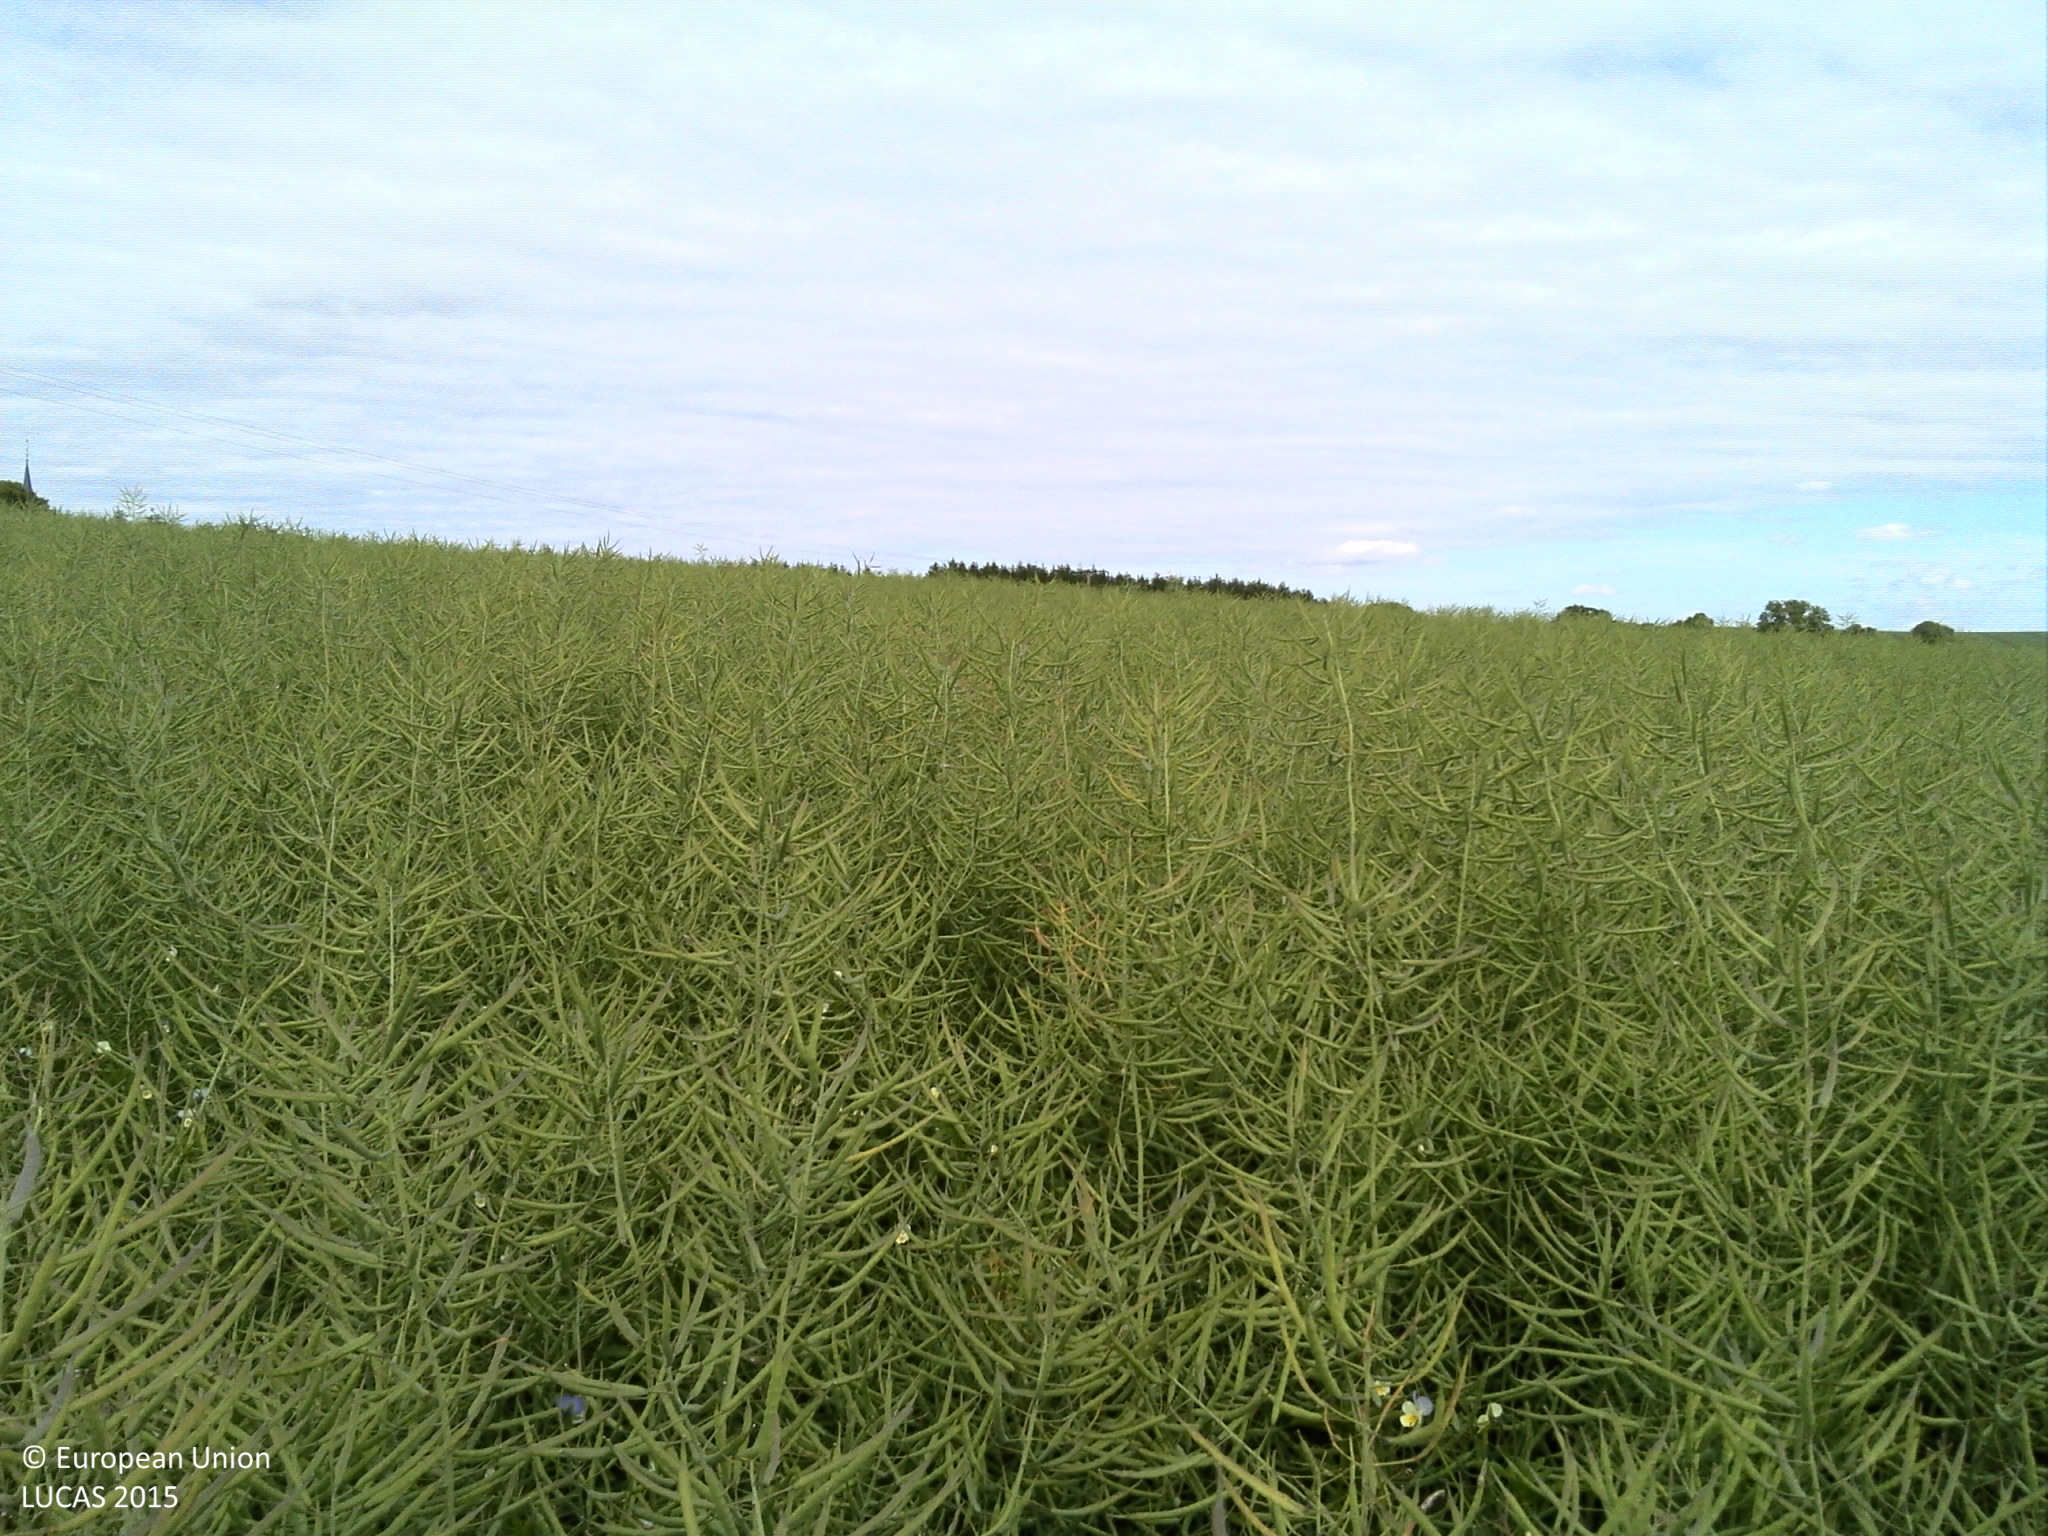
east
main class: Cropland
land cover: Rape and turnip rape
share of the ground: > 75 %
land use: Agriculture (excluding fallow land and kitchen gardens)
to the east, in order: Rape and turnip rape
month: June
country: FR
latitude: 48.9772
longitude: 6.4615
